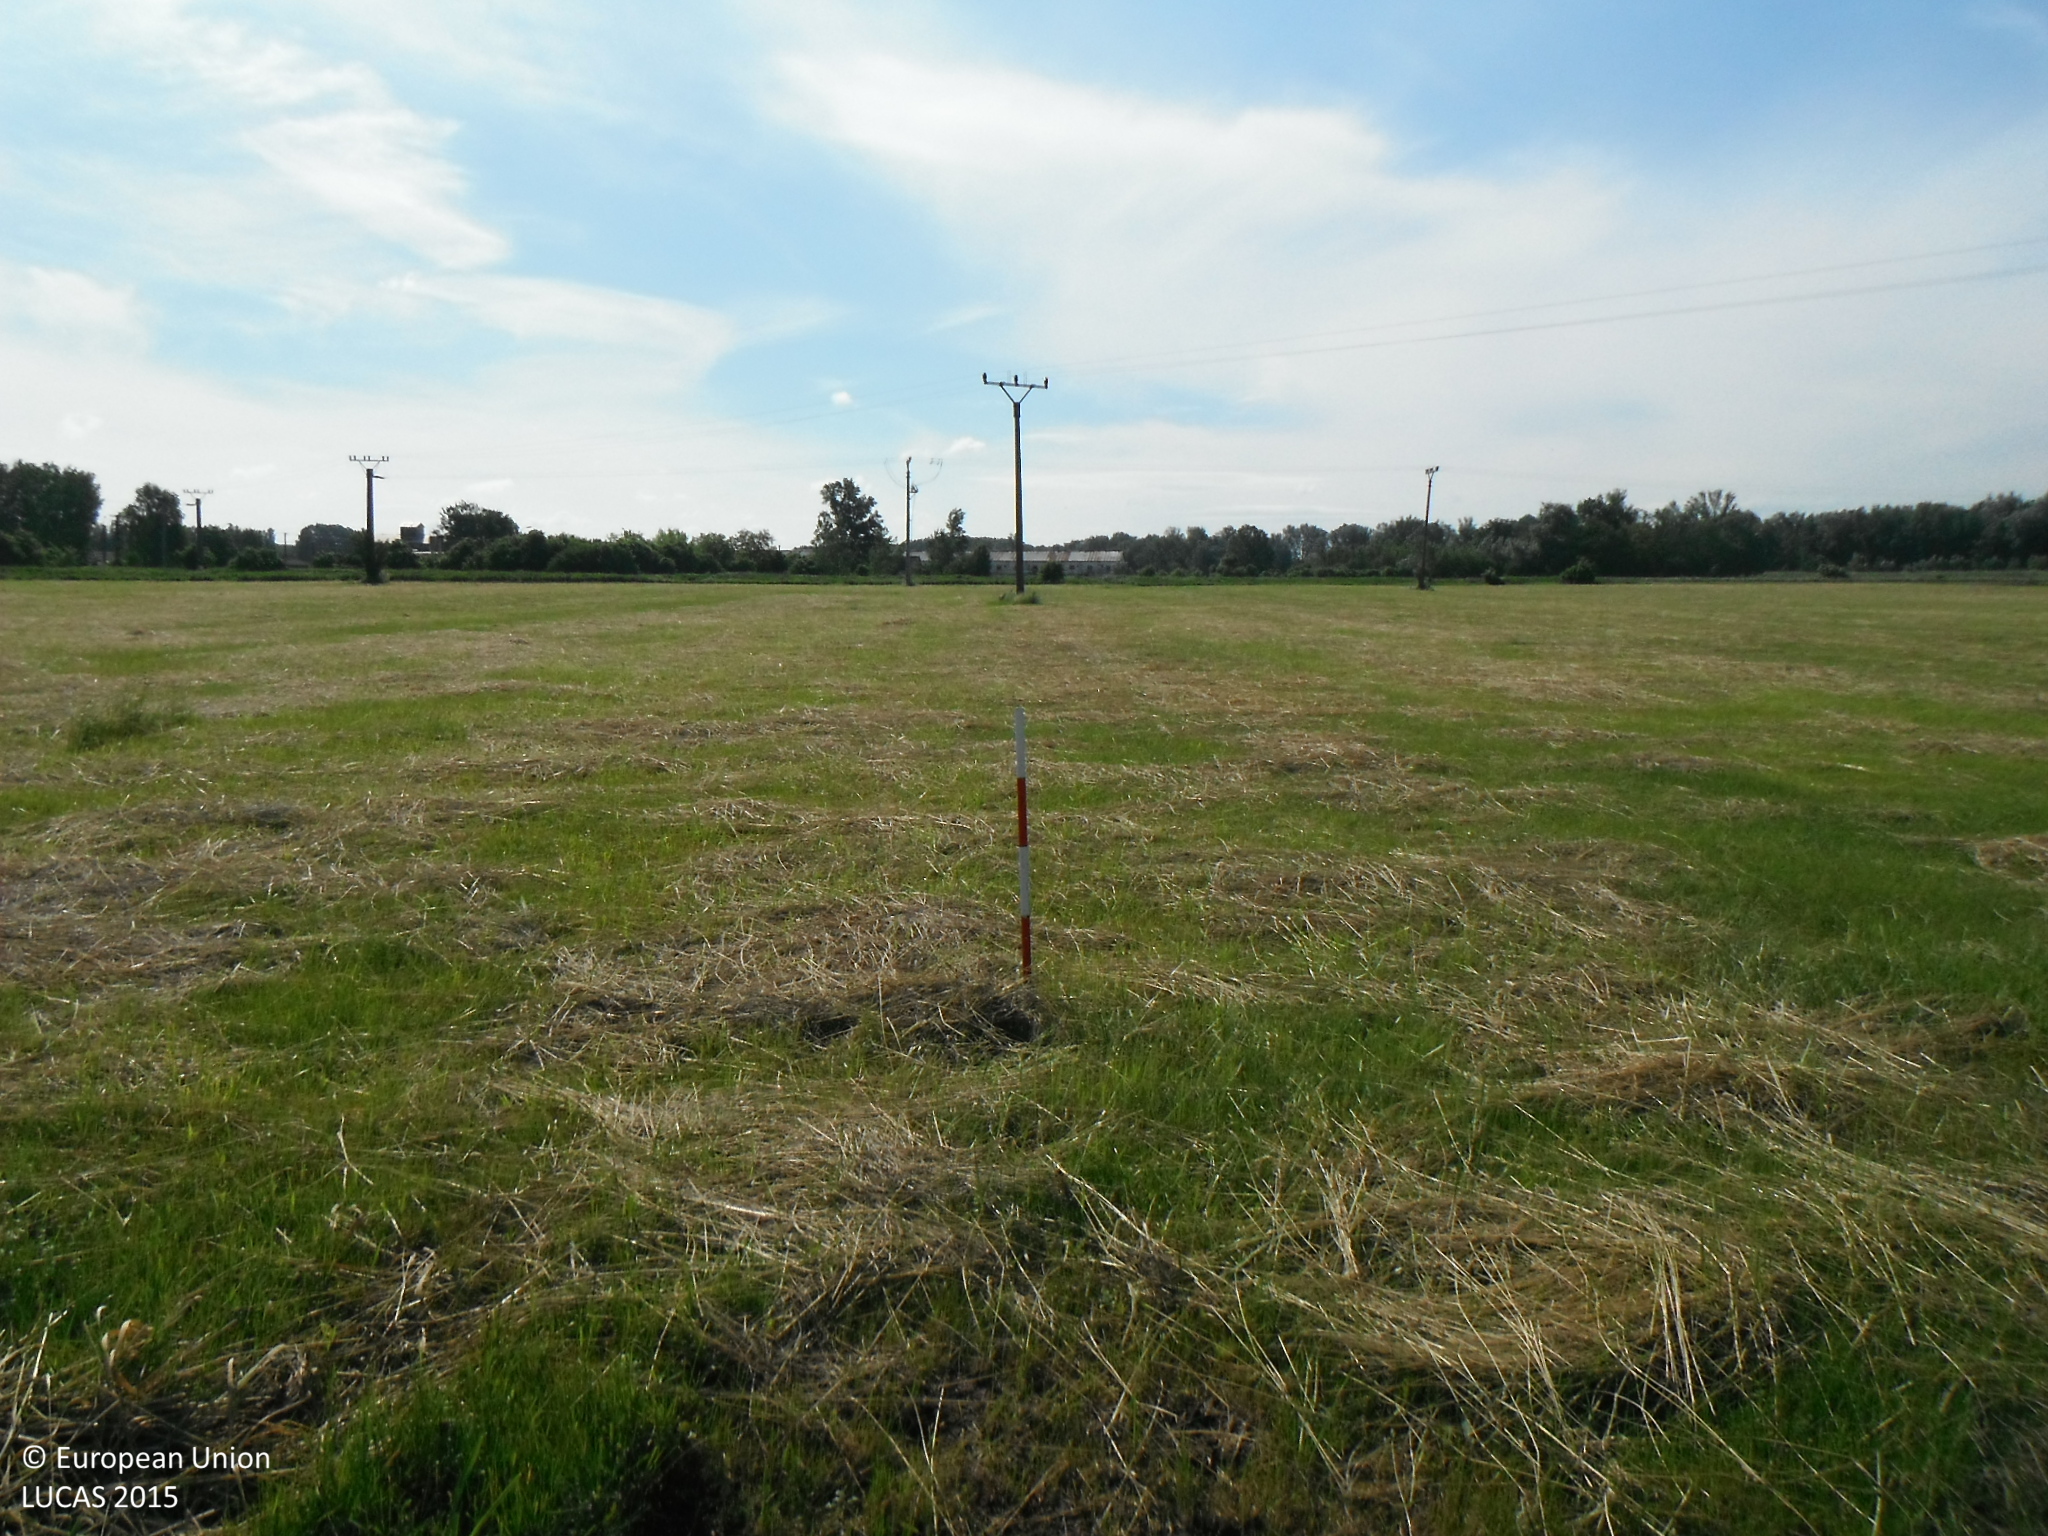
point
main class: Grassland
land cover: Grassland without tree/shrub cover
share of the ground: > 75 %
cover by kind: herbaceous plants 100 %
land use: Agriculture (excluding fallow land and kitchen gardens)
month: May
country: SK
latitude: 47.7905
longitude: 17.7123
